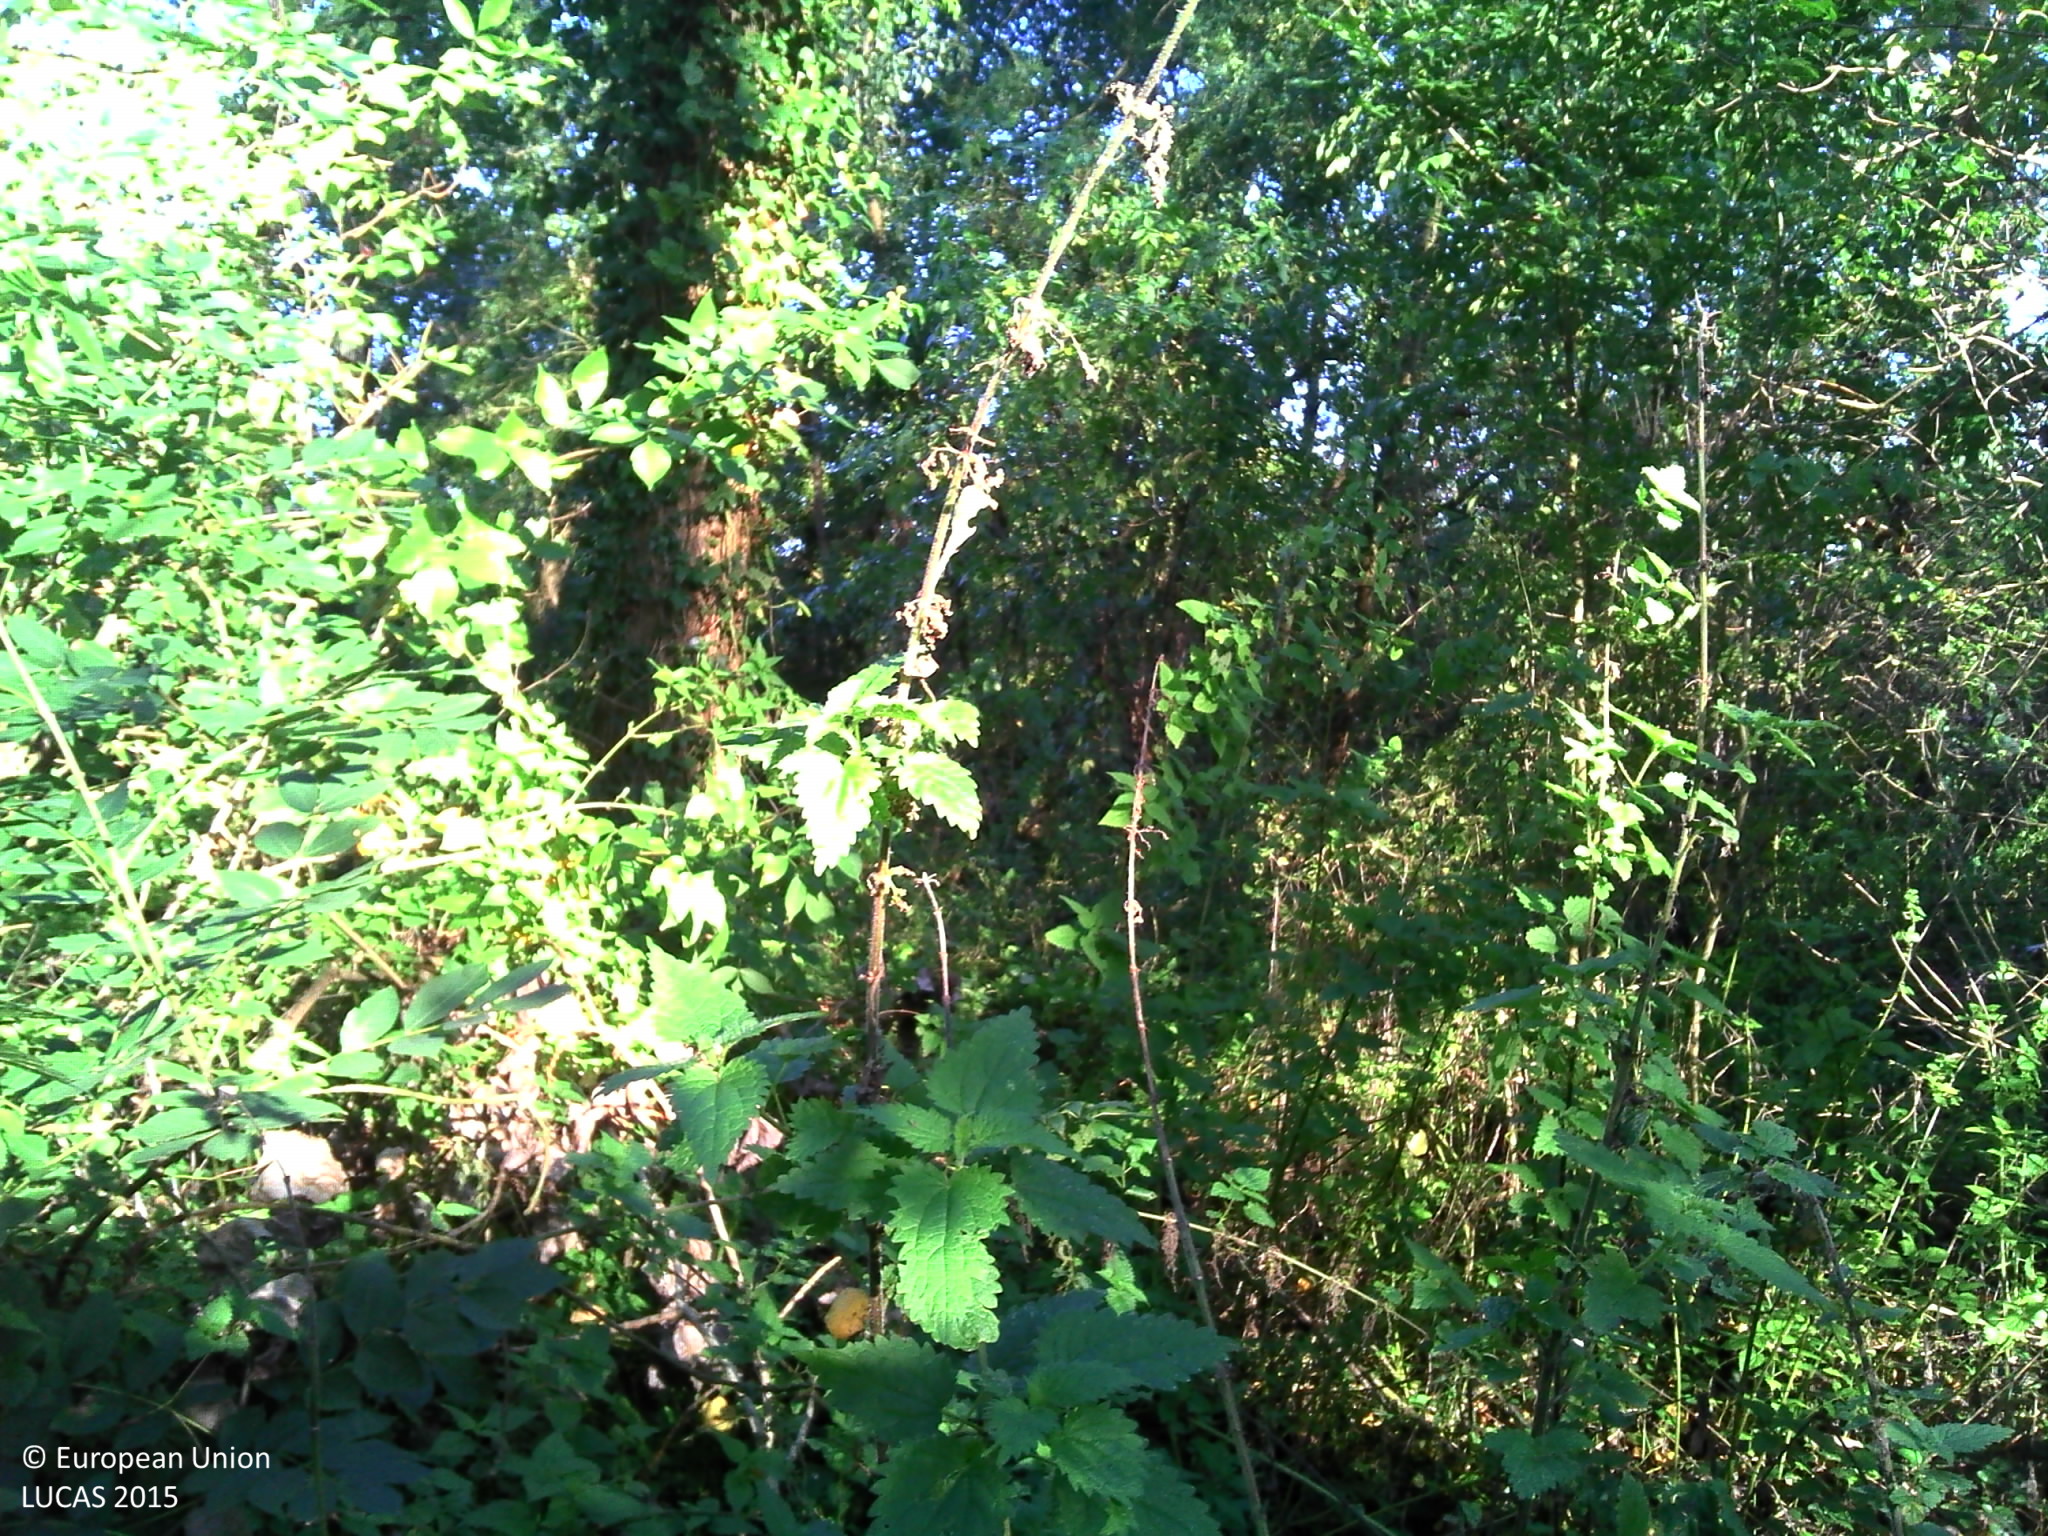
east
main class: Woodland
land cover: Broadleaved woodland
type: floodplain forest
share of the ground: 50 - 75 %
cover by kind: broadleaved forest trees 70 %, herbaceous plants 30 %
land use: Semi-natural and natural areas not in use
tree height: > 5 m
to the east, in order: Broadleaved woodland; Inland fresh running water; Broadleaved woodland; Tracks; Maize
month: September
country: FR
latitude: 46.5879
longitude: -1.1141
